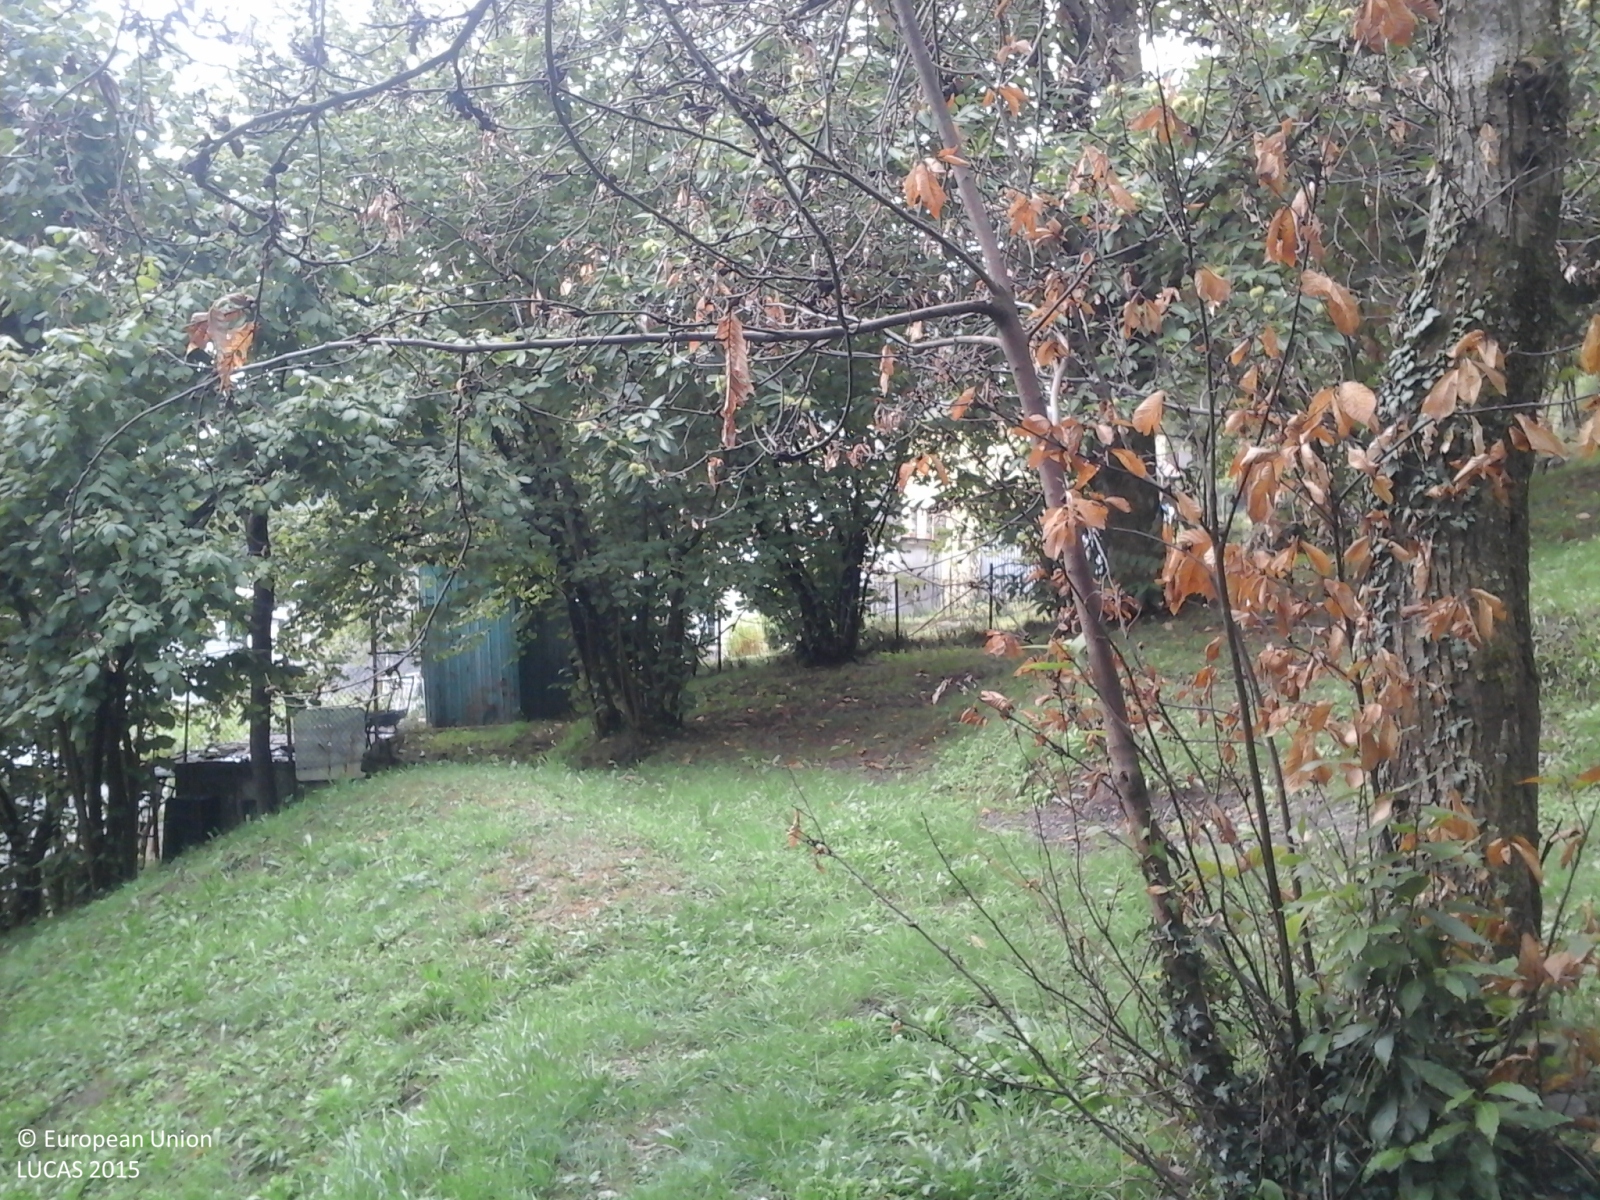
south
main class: Cropland
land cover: Nuts trees
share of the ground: > 75 %
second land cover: Grassland without tree/shrub cover
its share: > 75 %
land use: Agriculture (excluding fallow land and kitchen gardens)
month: September
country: IT
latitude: 44.4369
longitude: 9.1100
